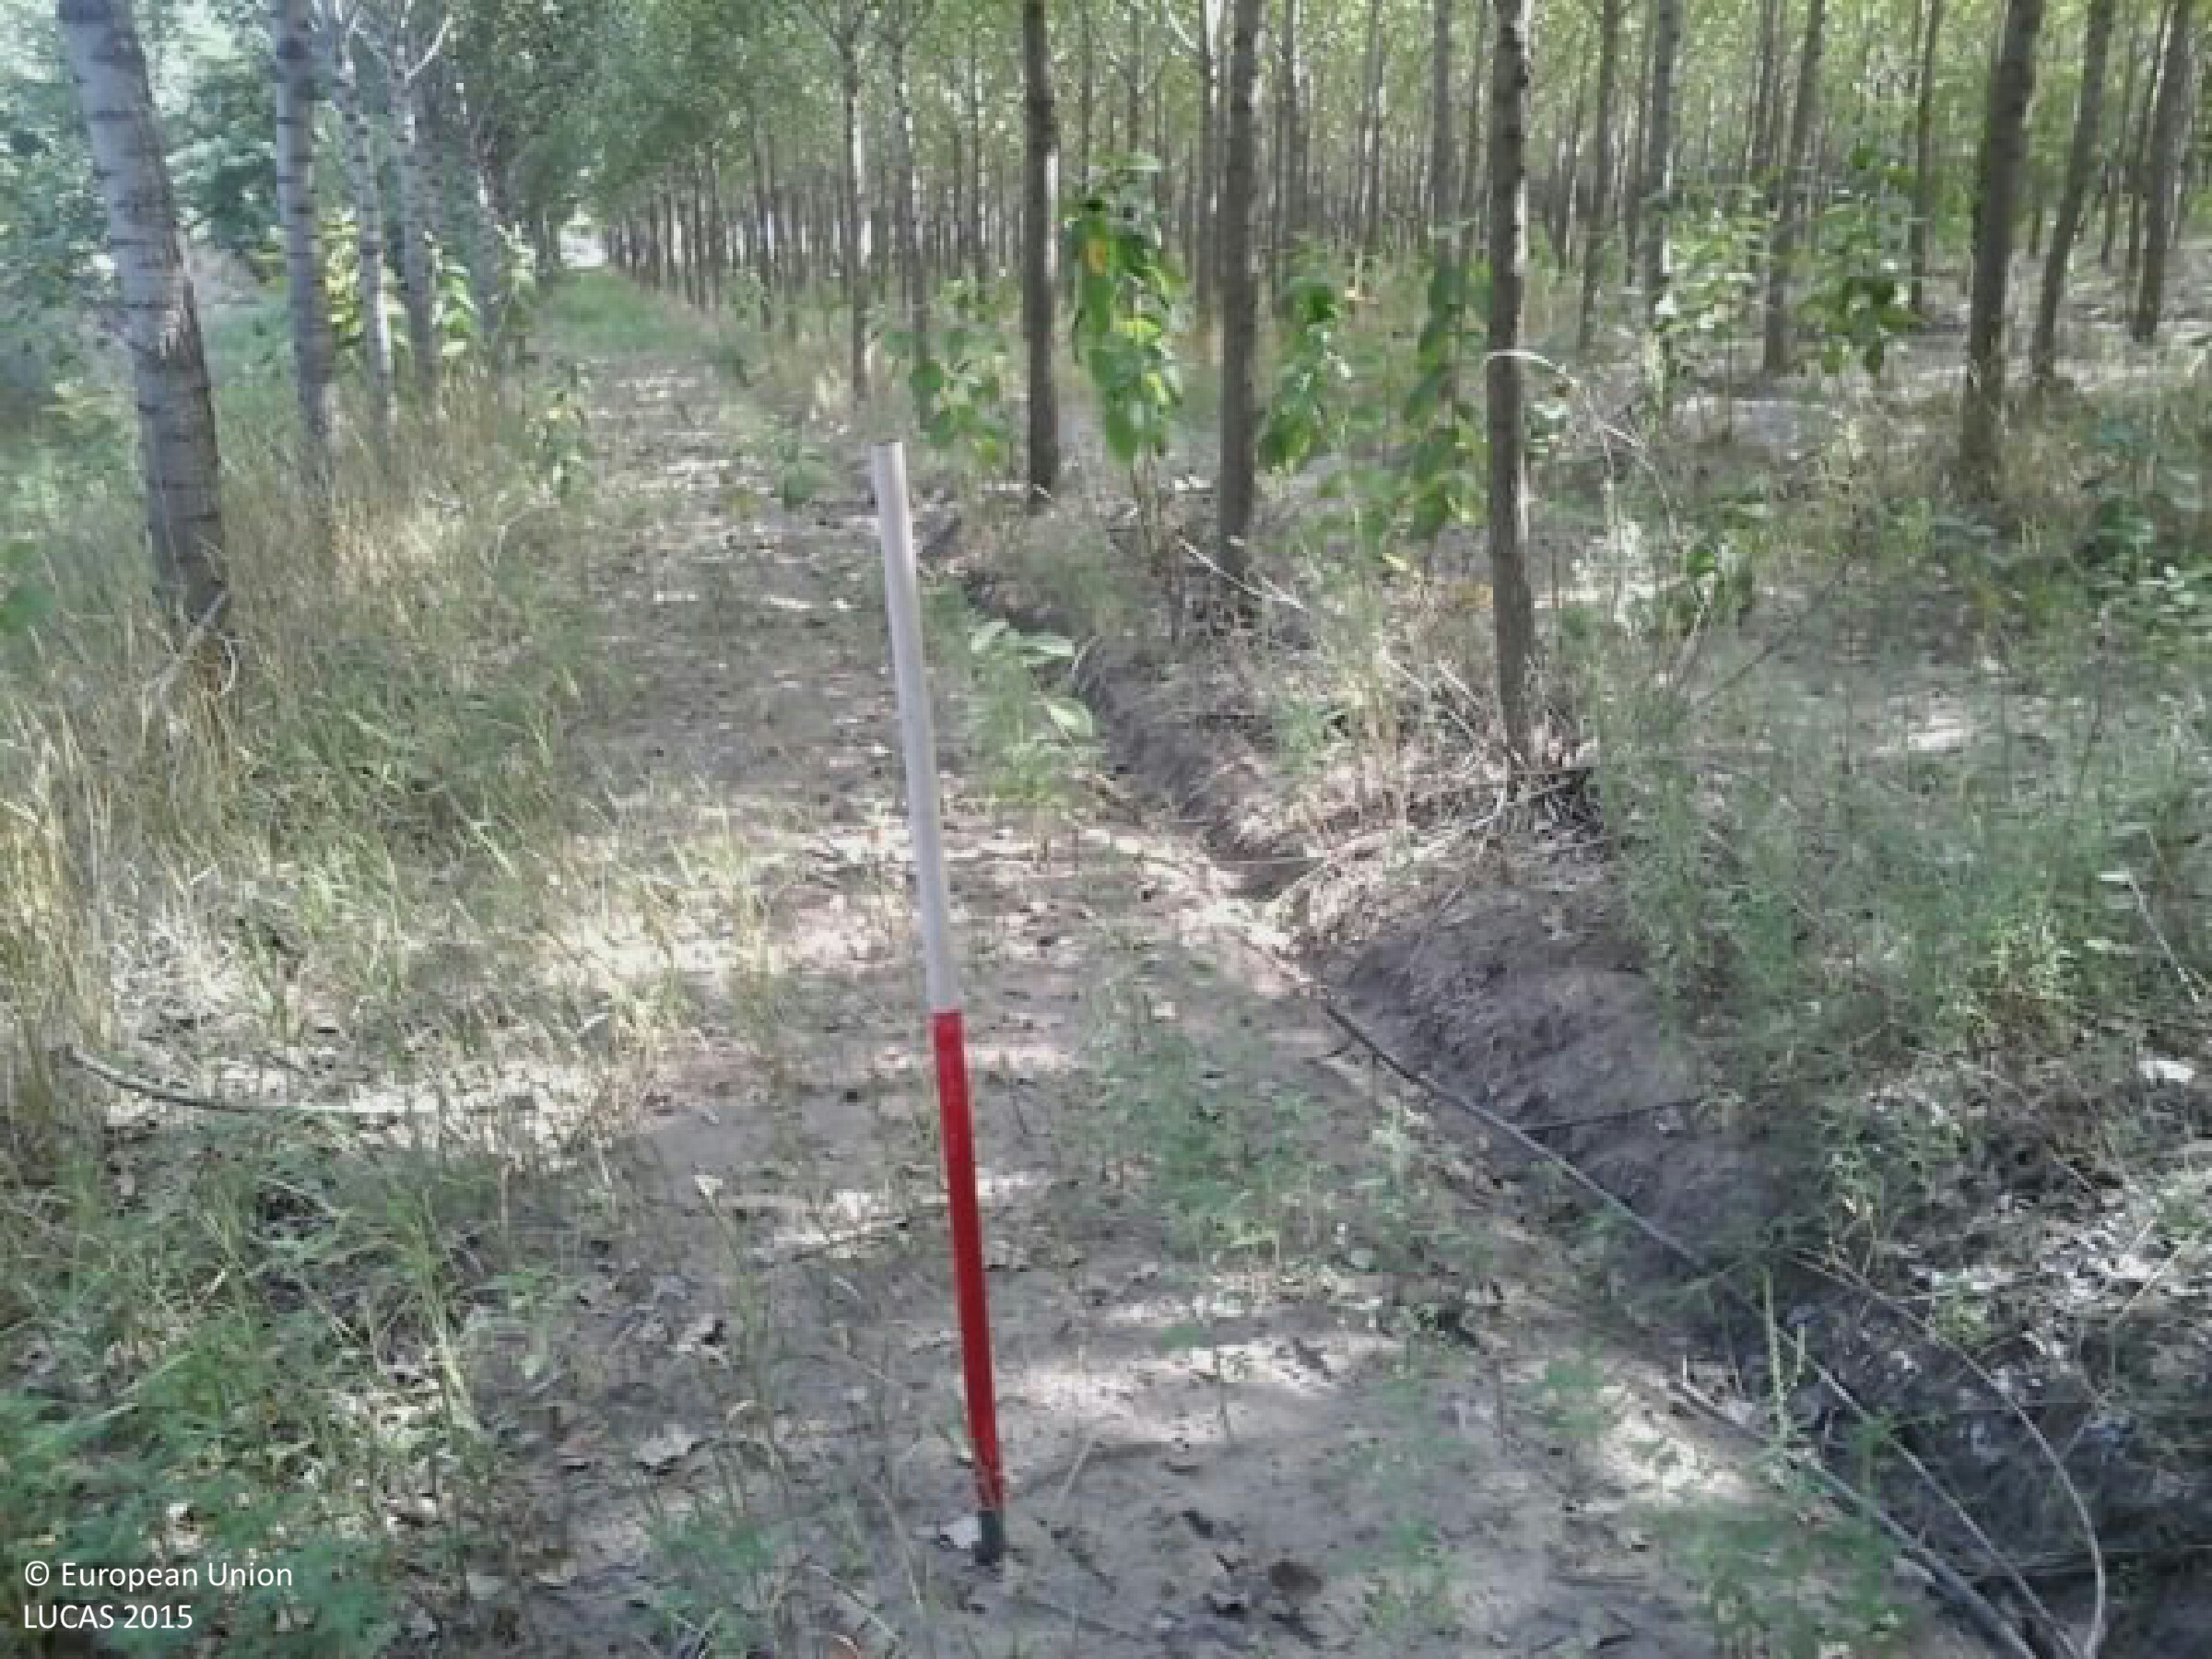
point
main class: Woodland
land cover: Broadleaved woodland
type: non-riverine alder, birch or aspen forest
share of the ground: 50 - 75 %
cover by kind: broadleaved forest trees 85 %, unconsolidated bare surface 15 %
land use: Forestry
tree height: > 5 m
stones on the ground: < 10 %
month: August
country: HU
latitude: 47.0782
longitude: 19.8080
